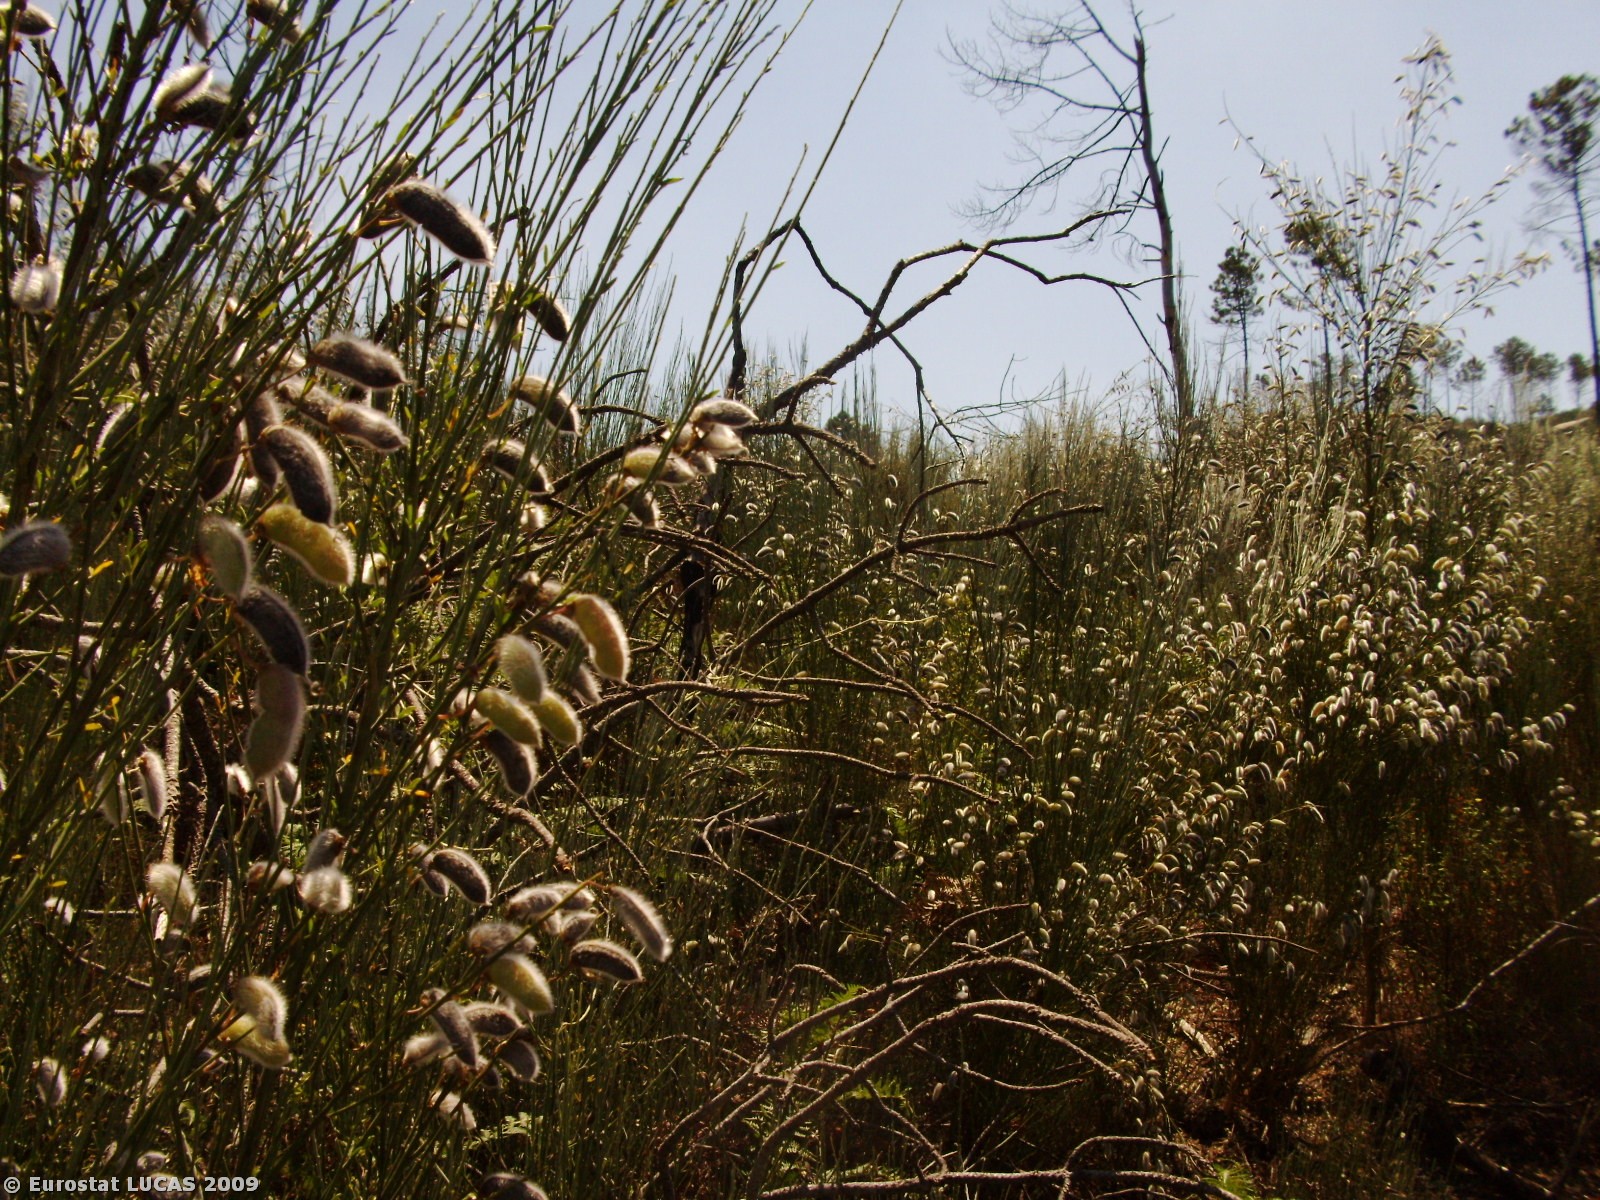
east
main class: Woodland
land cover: Broadleaved woodland
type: mesophytic deciduous forest
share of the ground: 10 - 25 %
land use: Forestry
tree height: > 5 m
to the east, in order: Broadleaved woodland; Shrubland without tree cover; Bare land; Shrubland without tree cover; Tracks; Shrubland with sparse tree cover; Coniferous woodland; Rock outcrops; Shrubland with sparse tree cover
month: July
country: PT
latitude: 40.6634
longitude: -7.6595
